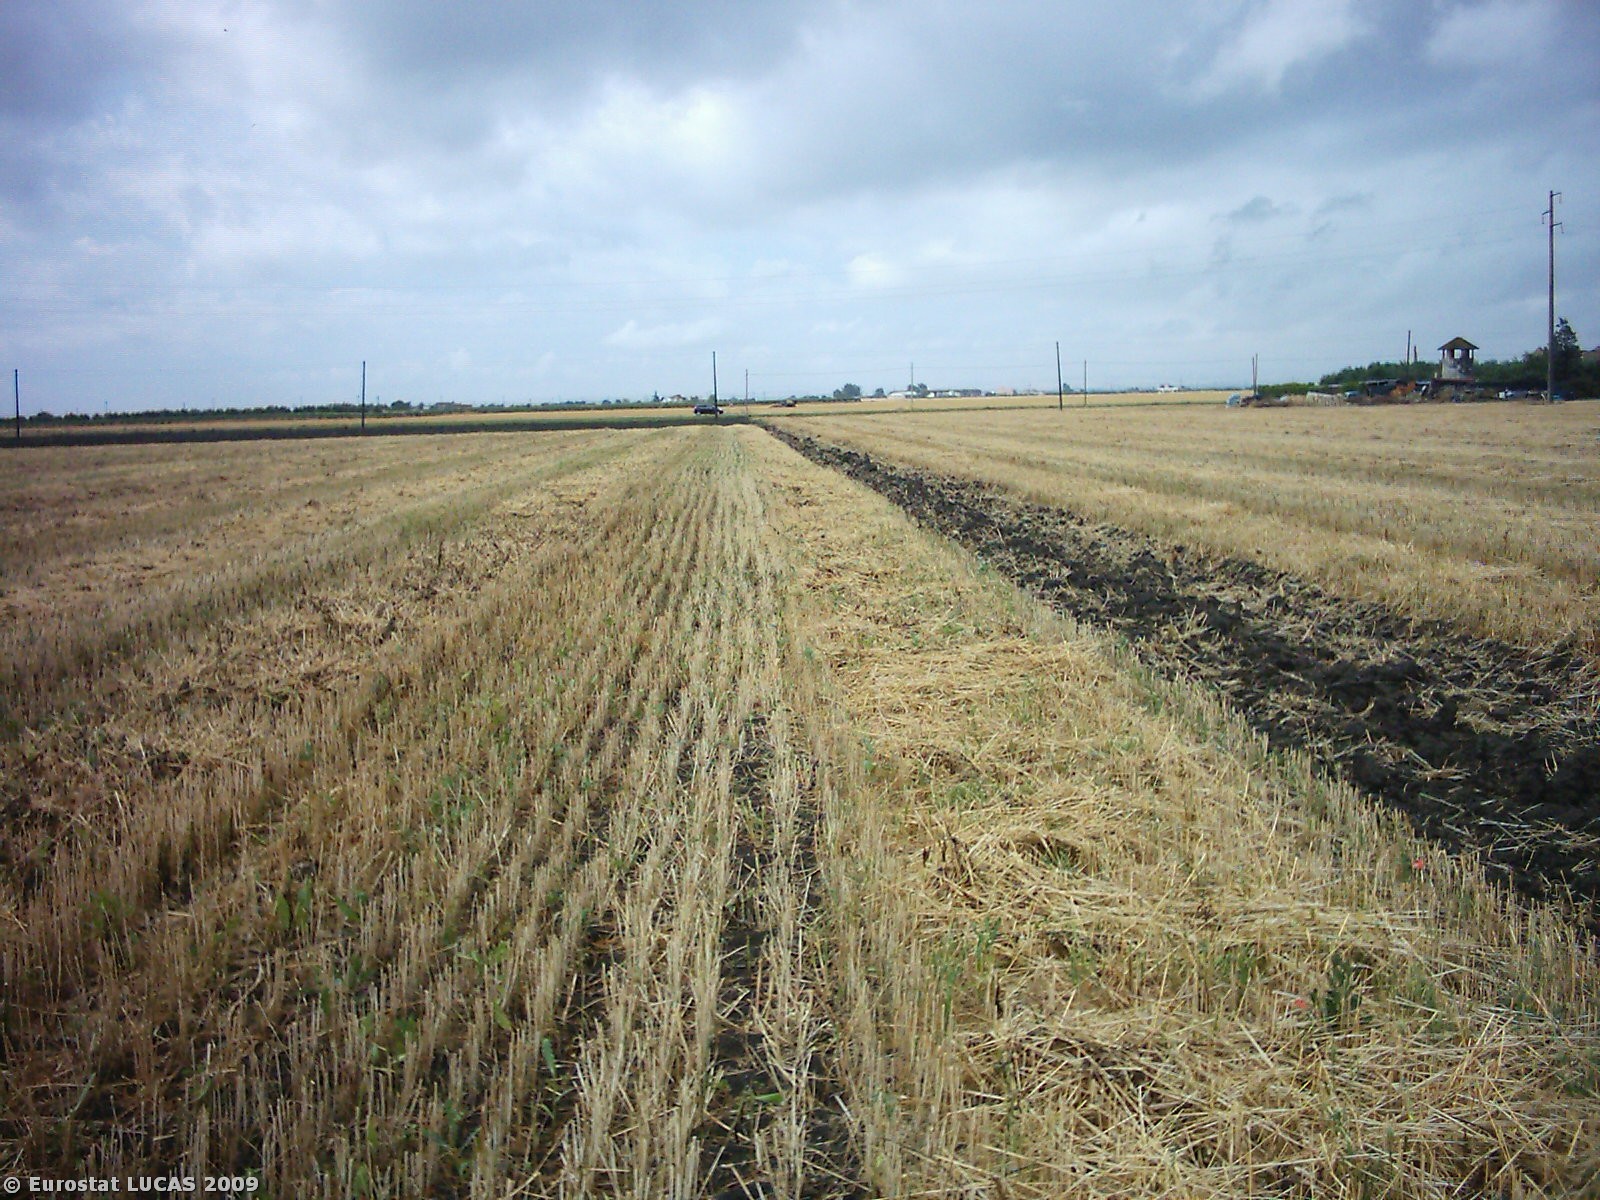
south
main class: Cropland
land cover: Durum wheat
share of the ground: > 75 %
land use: Agriculture (excluding fallow land and kitchen gardens)
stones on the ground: < 10 %
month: June
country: IT
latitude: 41.4256
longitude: 15.6893
